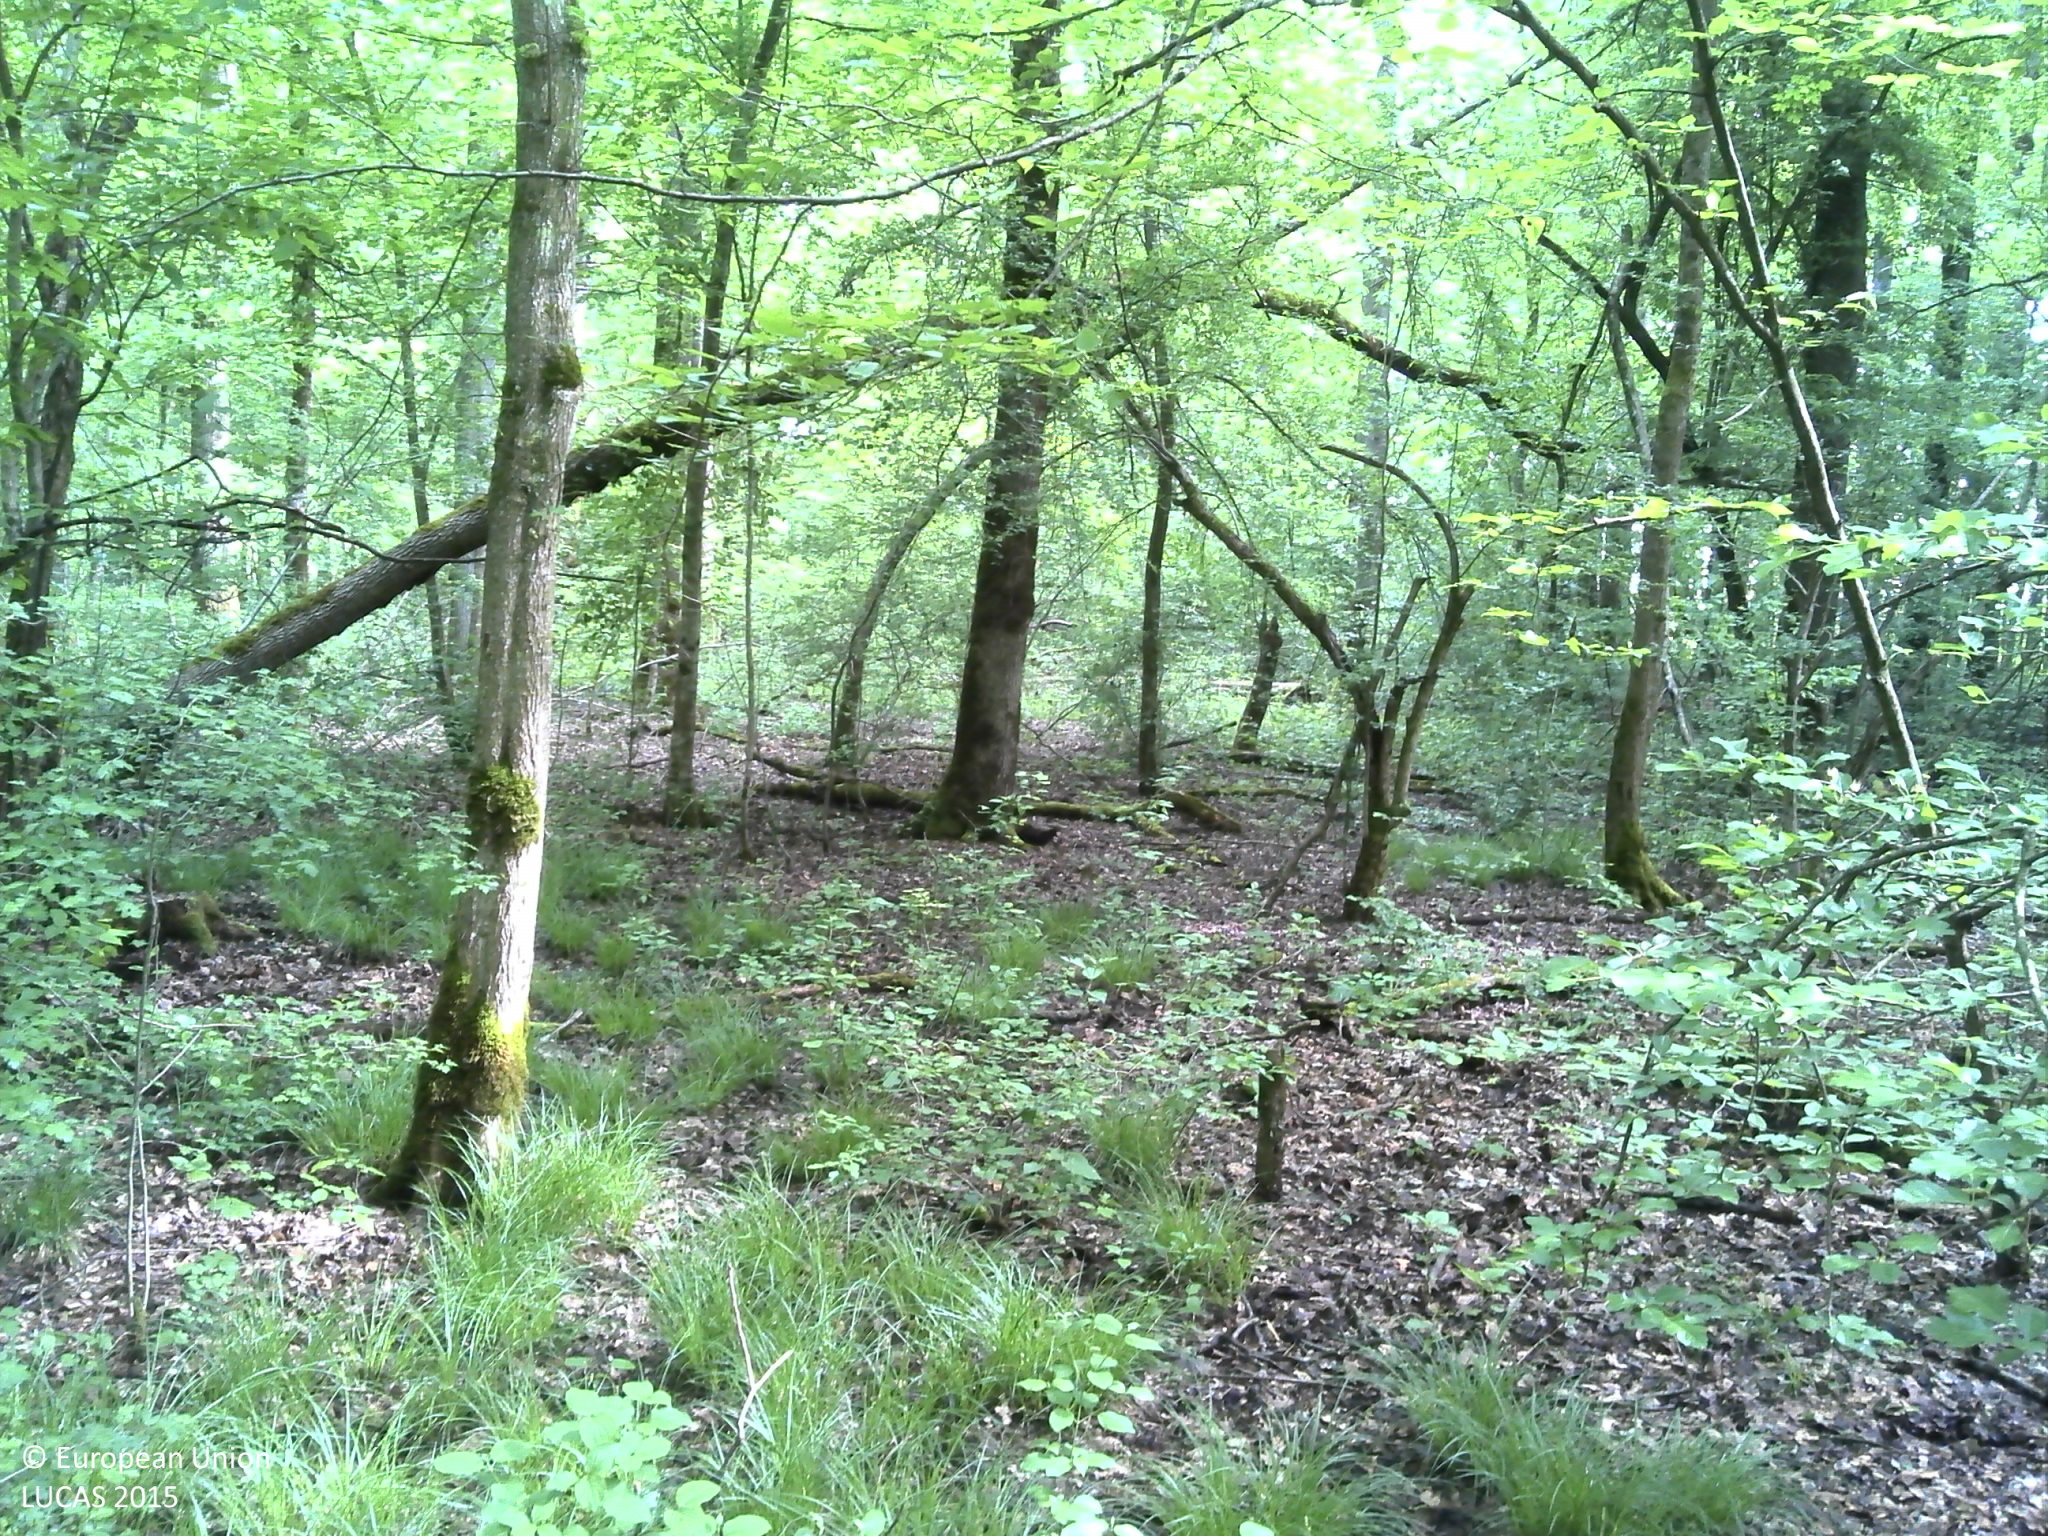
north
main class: Woodland
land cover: Broadleaved woodland
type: mesophytic deciduous forest
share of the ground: > 75 %
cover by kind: broadleaved forest trees 100 %
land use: Forestry
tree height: > 5 m
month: May
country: HR
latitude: 45.0347
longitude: 18.9304
